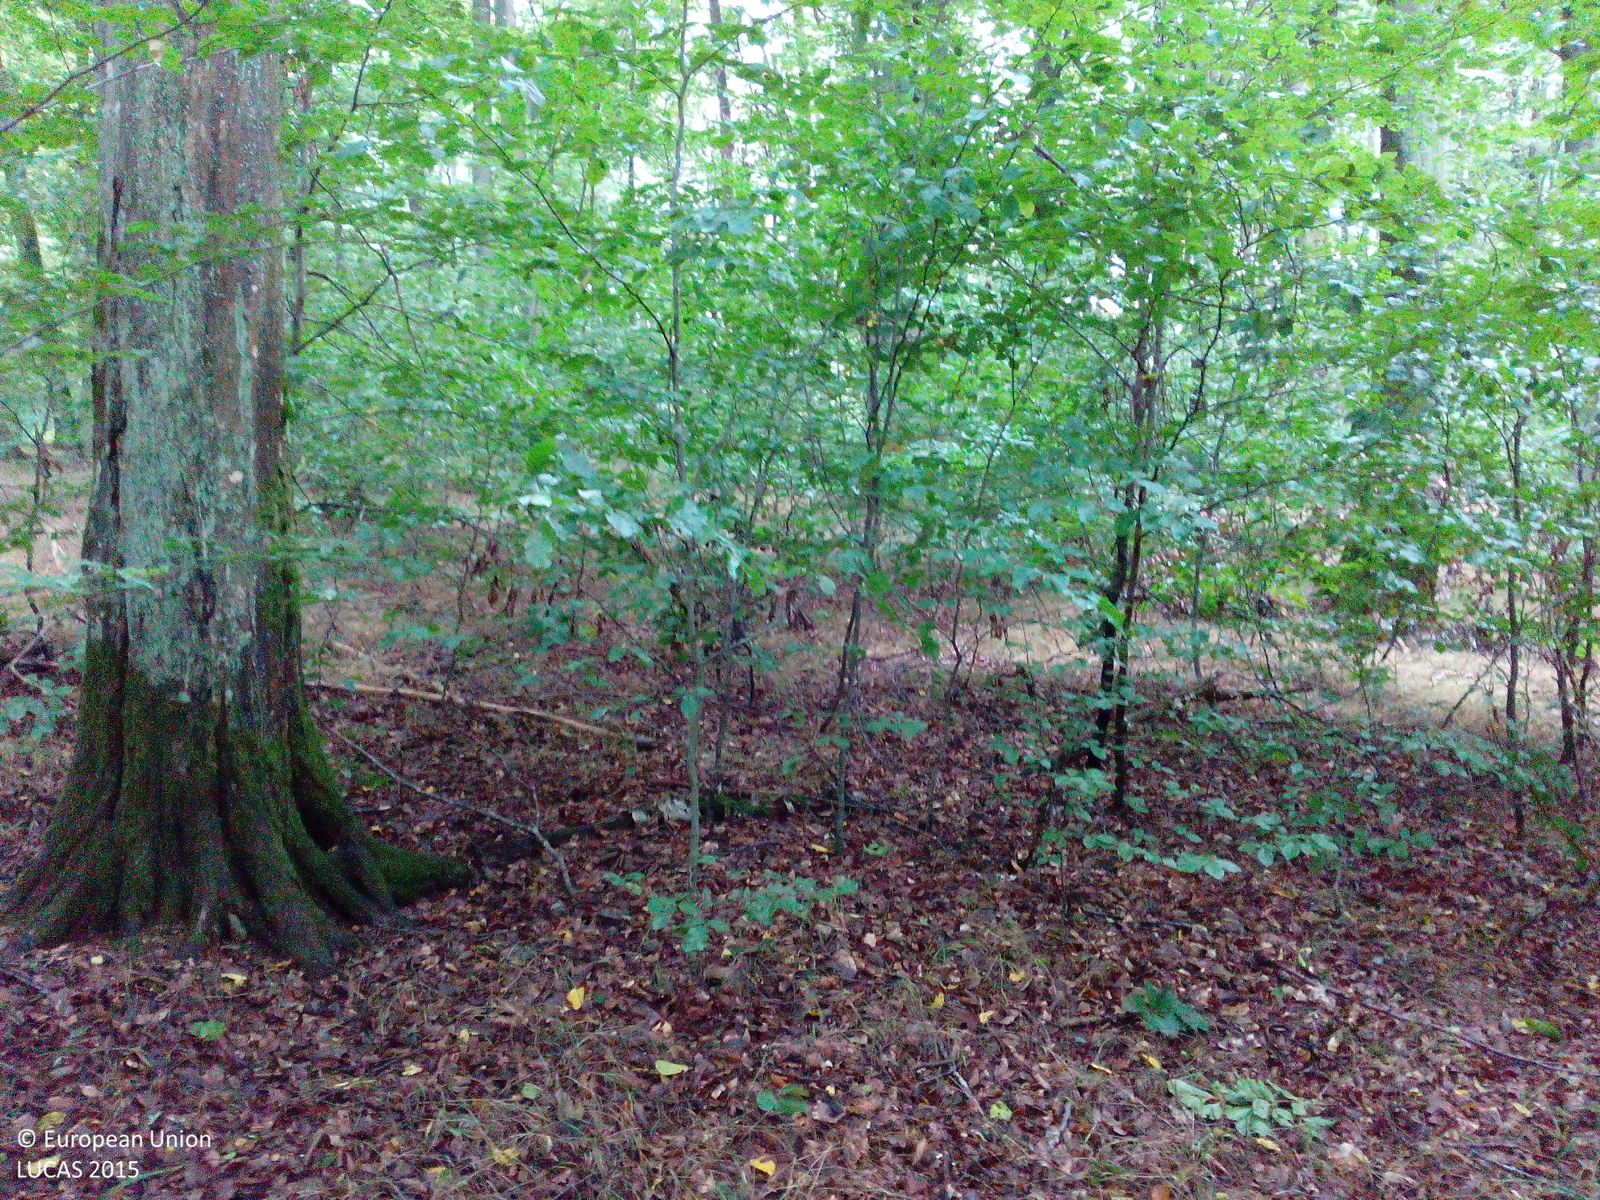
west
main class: Woodland
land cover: Broadleaved woodland
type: beech forest
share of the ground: > 75 %
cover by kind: broadleaved forest trees 95 %, herbaceous plants 5 %
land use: Forestry
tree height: > 5 m
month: September
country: DE
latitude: 49.9145
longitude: 9.9582
